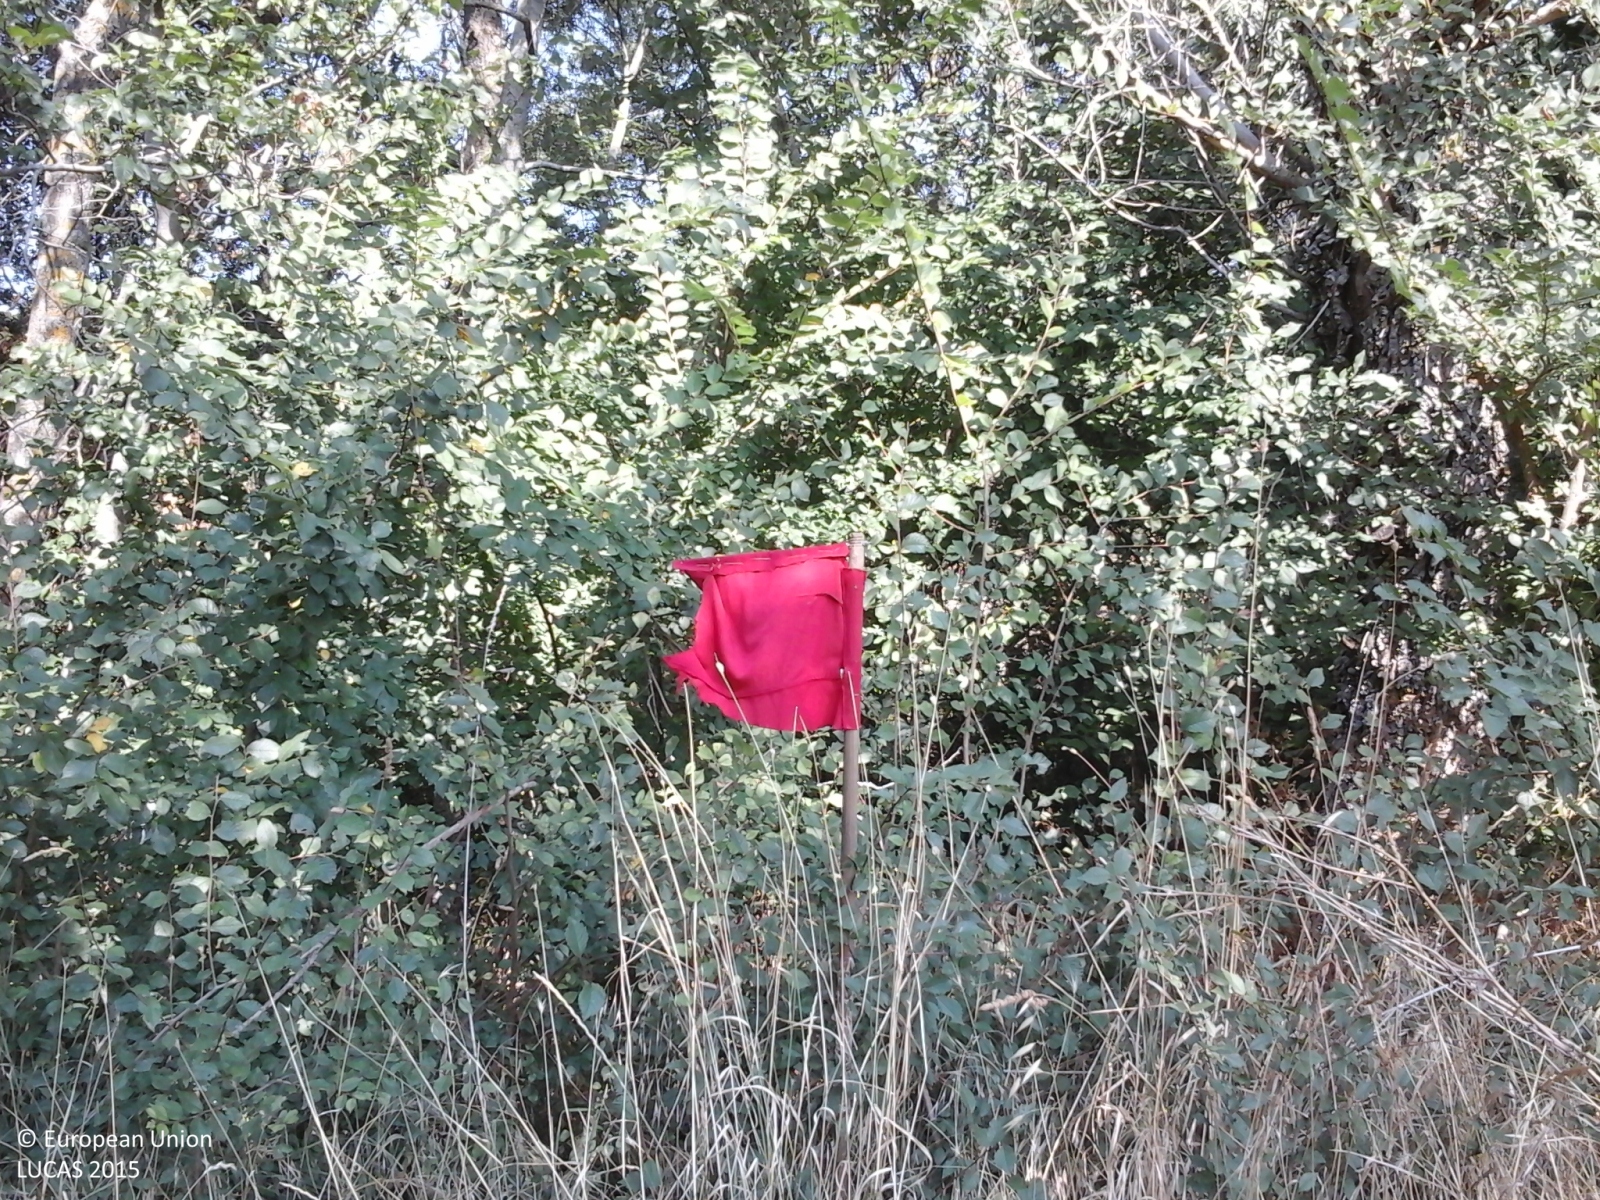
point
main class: Woodland
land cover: Broadleaved woodland
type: thermophilous deciduous forest
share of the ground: > 75 %
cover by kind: broadleaved forest trees 90 %, shrubs 5 %, herbaceous plants 5 %
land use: Forestry
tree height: > 5 m
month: August
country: IT
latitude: 41.4386
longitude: 15.1168
